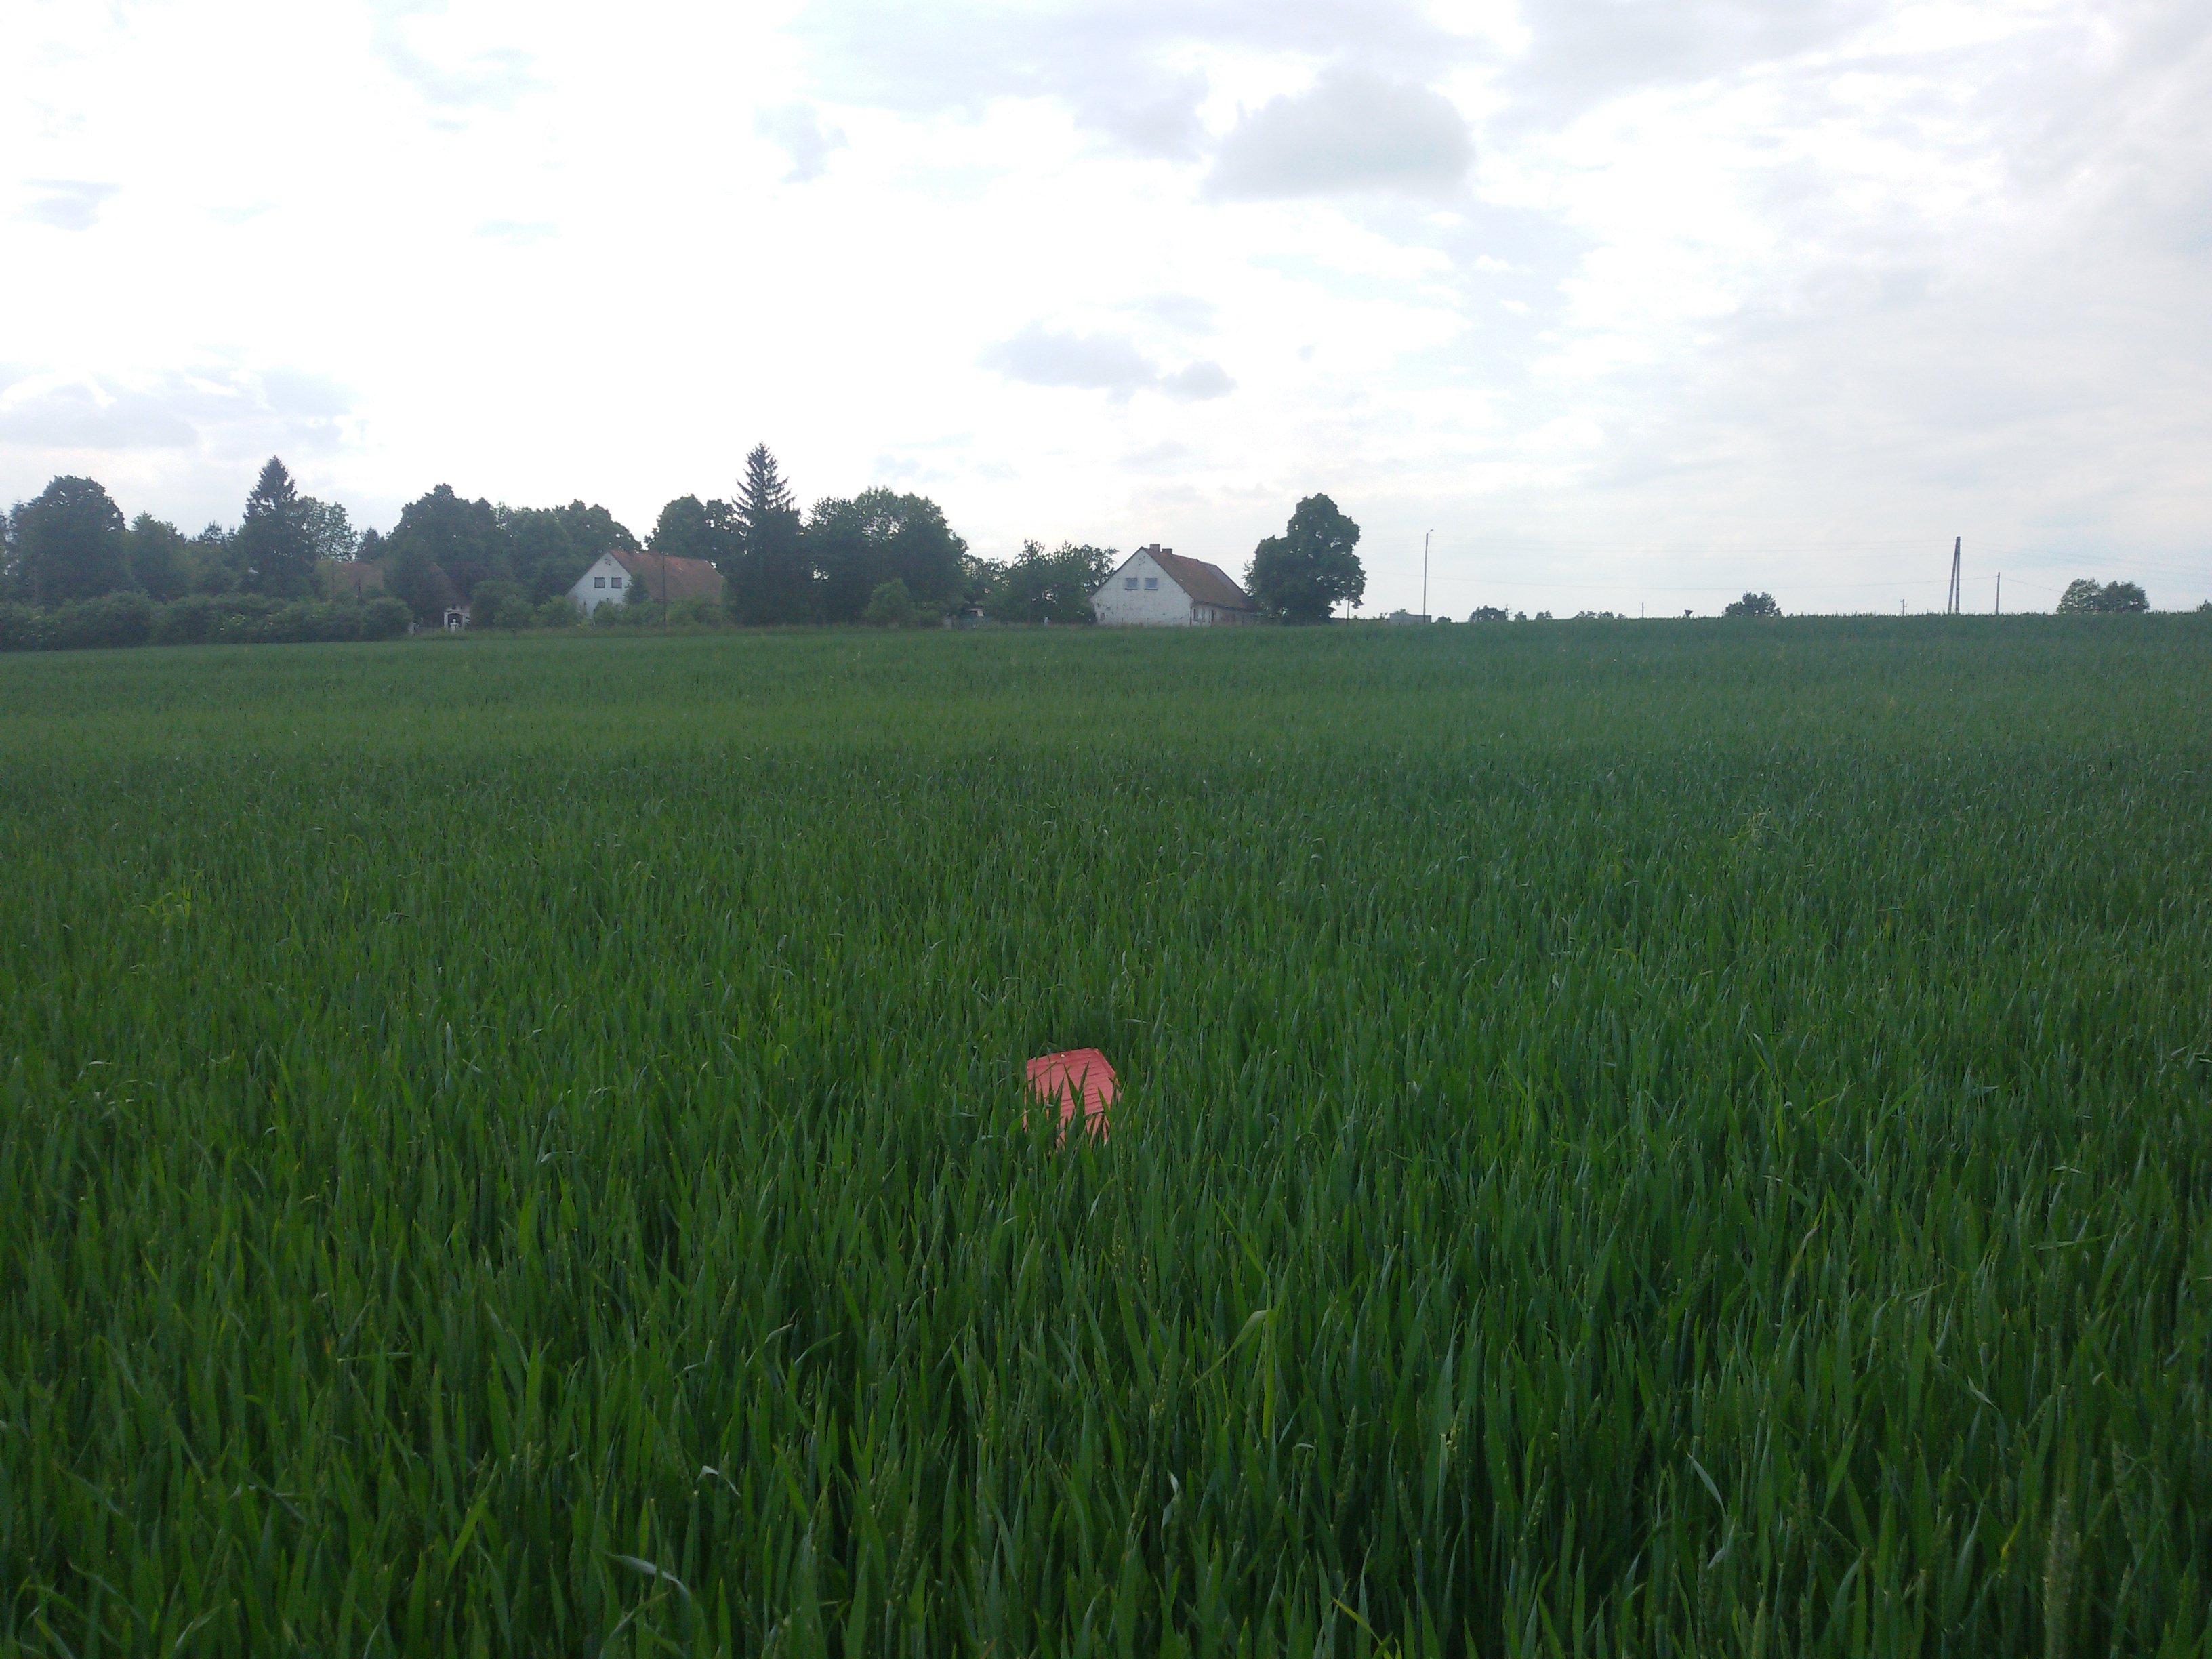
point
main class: Cropland
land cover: Common wheat
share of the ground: > 75 %
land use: Agriculture (excluding fallow land and kitchen gardens)
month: May
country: PL
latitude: 50.5347
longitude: 17.1923
